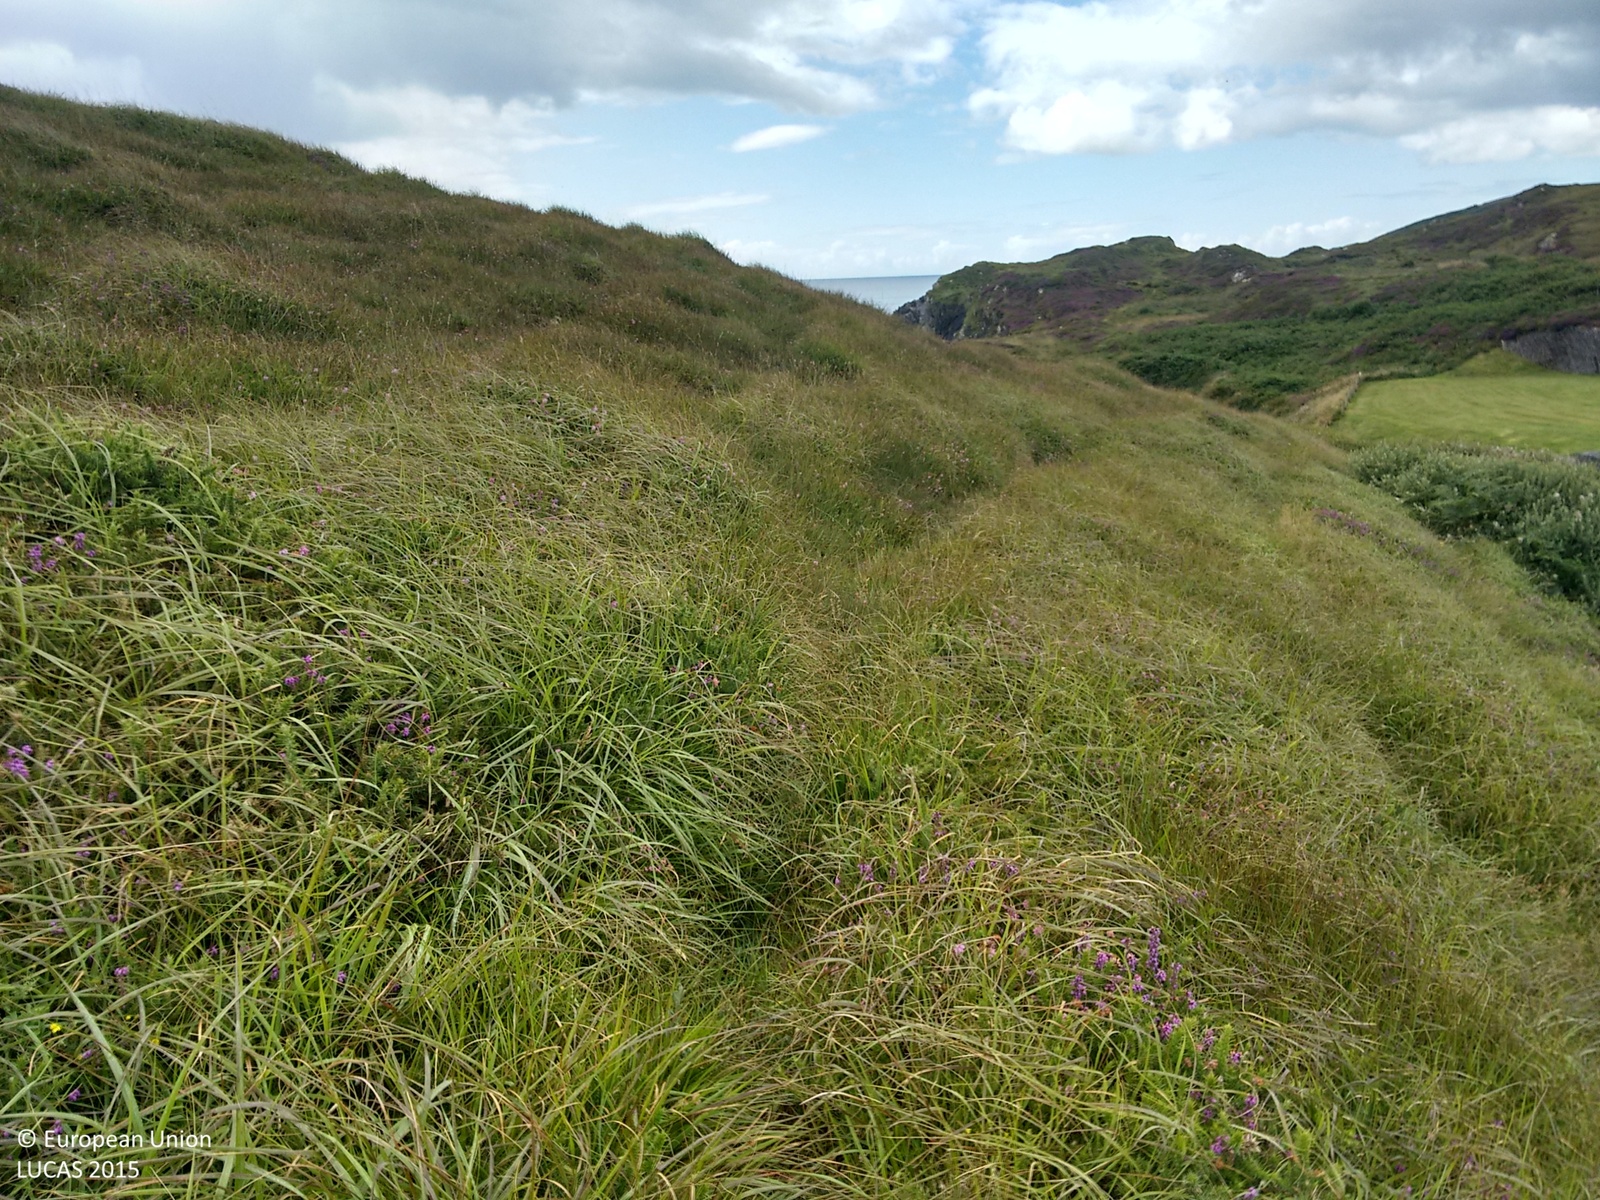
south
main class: Shrubland
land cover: Shrubland without tree cover
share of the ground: > 75 %
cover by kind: shrubs 80 %, herbaceous plants 20 %
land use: Semi-natural and natural areas not in use
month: July
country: IE
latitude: 51.4961
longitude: -9.2806
